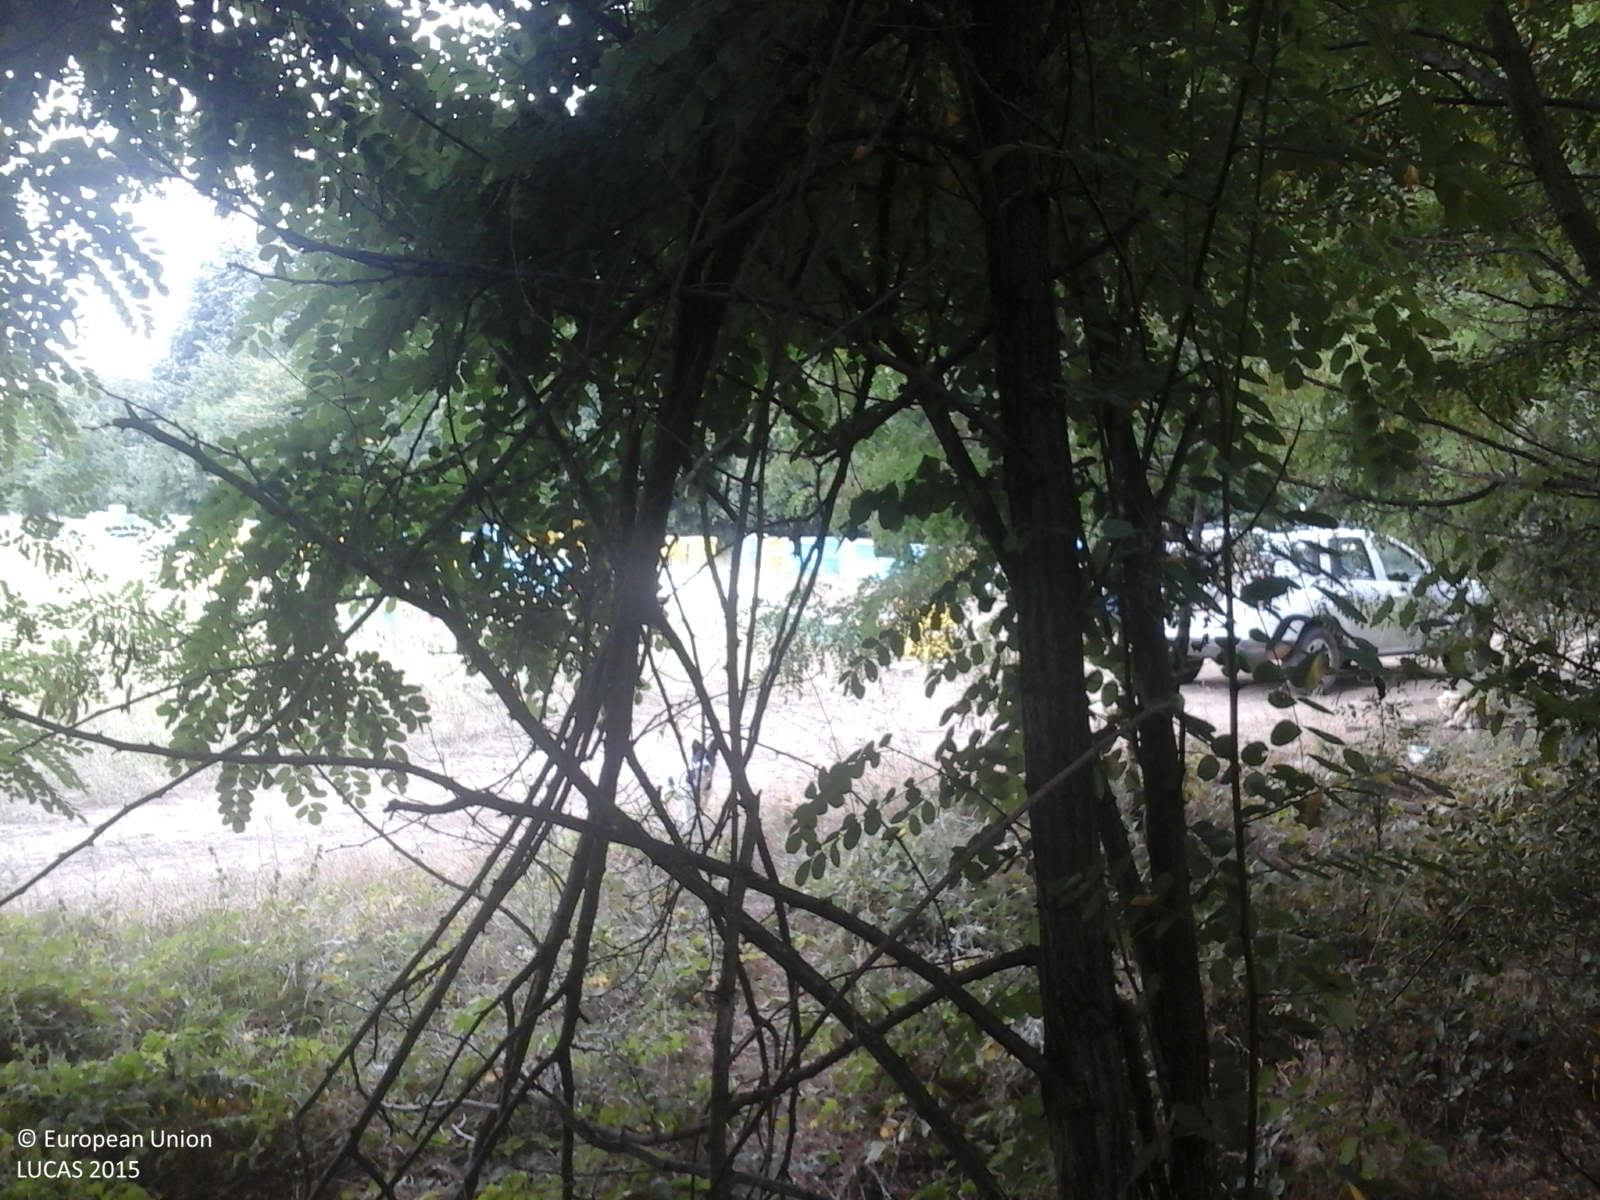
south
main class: Woodland
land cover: Broadleaved woodland
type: exotic forest
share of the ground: > 75 %
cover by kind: broadleaved forest trees 100 %
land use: Forestry
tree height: > 5 m
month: July
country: RO
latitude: 45.1296
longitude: 28.3714
